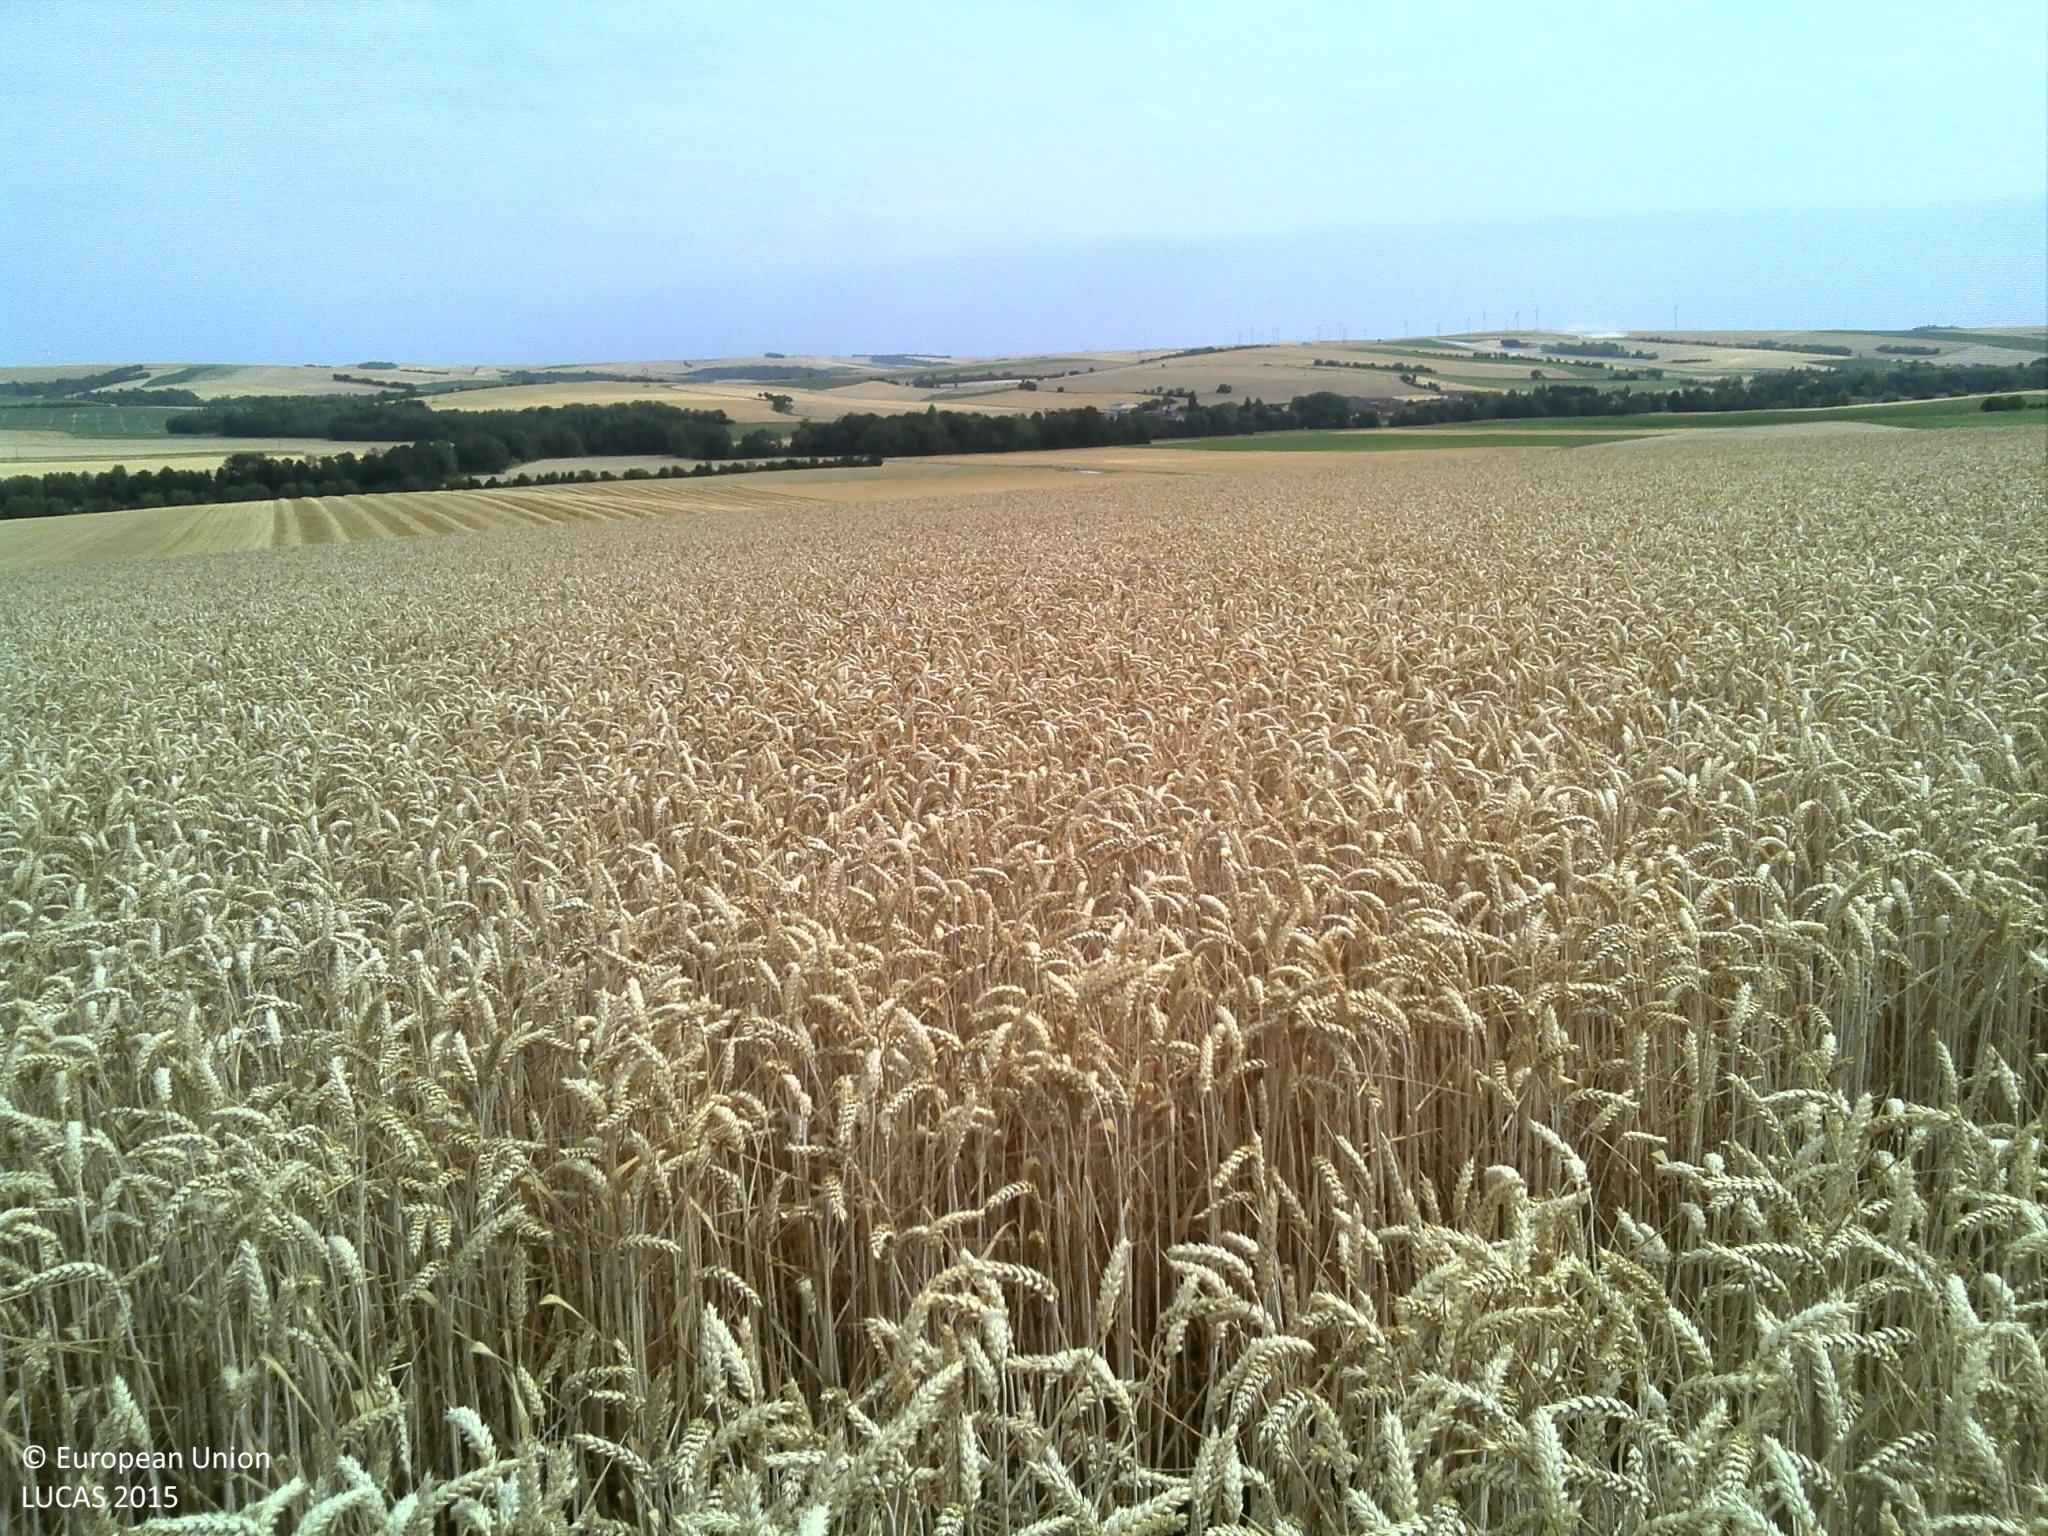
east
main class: Cropland
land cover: Common wheat
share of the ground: > 75 %
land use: Agriculture (excluding fallow land and kitchen gardens)
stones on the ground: < 10 %
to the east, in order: Common wheat
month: July
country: FR
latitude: 48.8108
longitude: 4.5637
